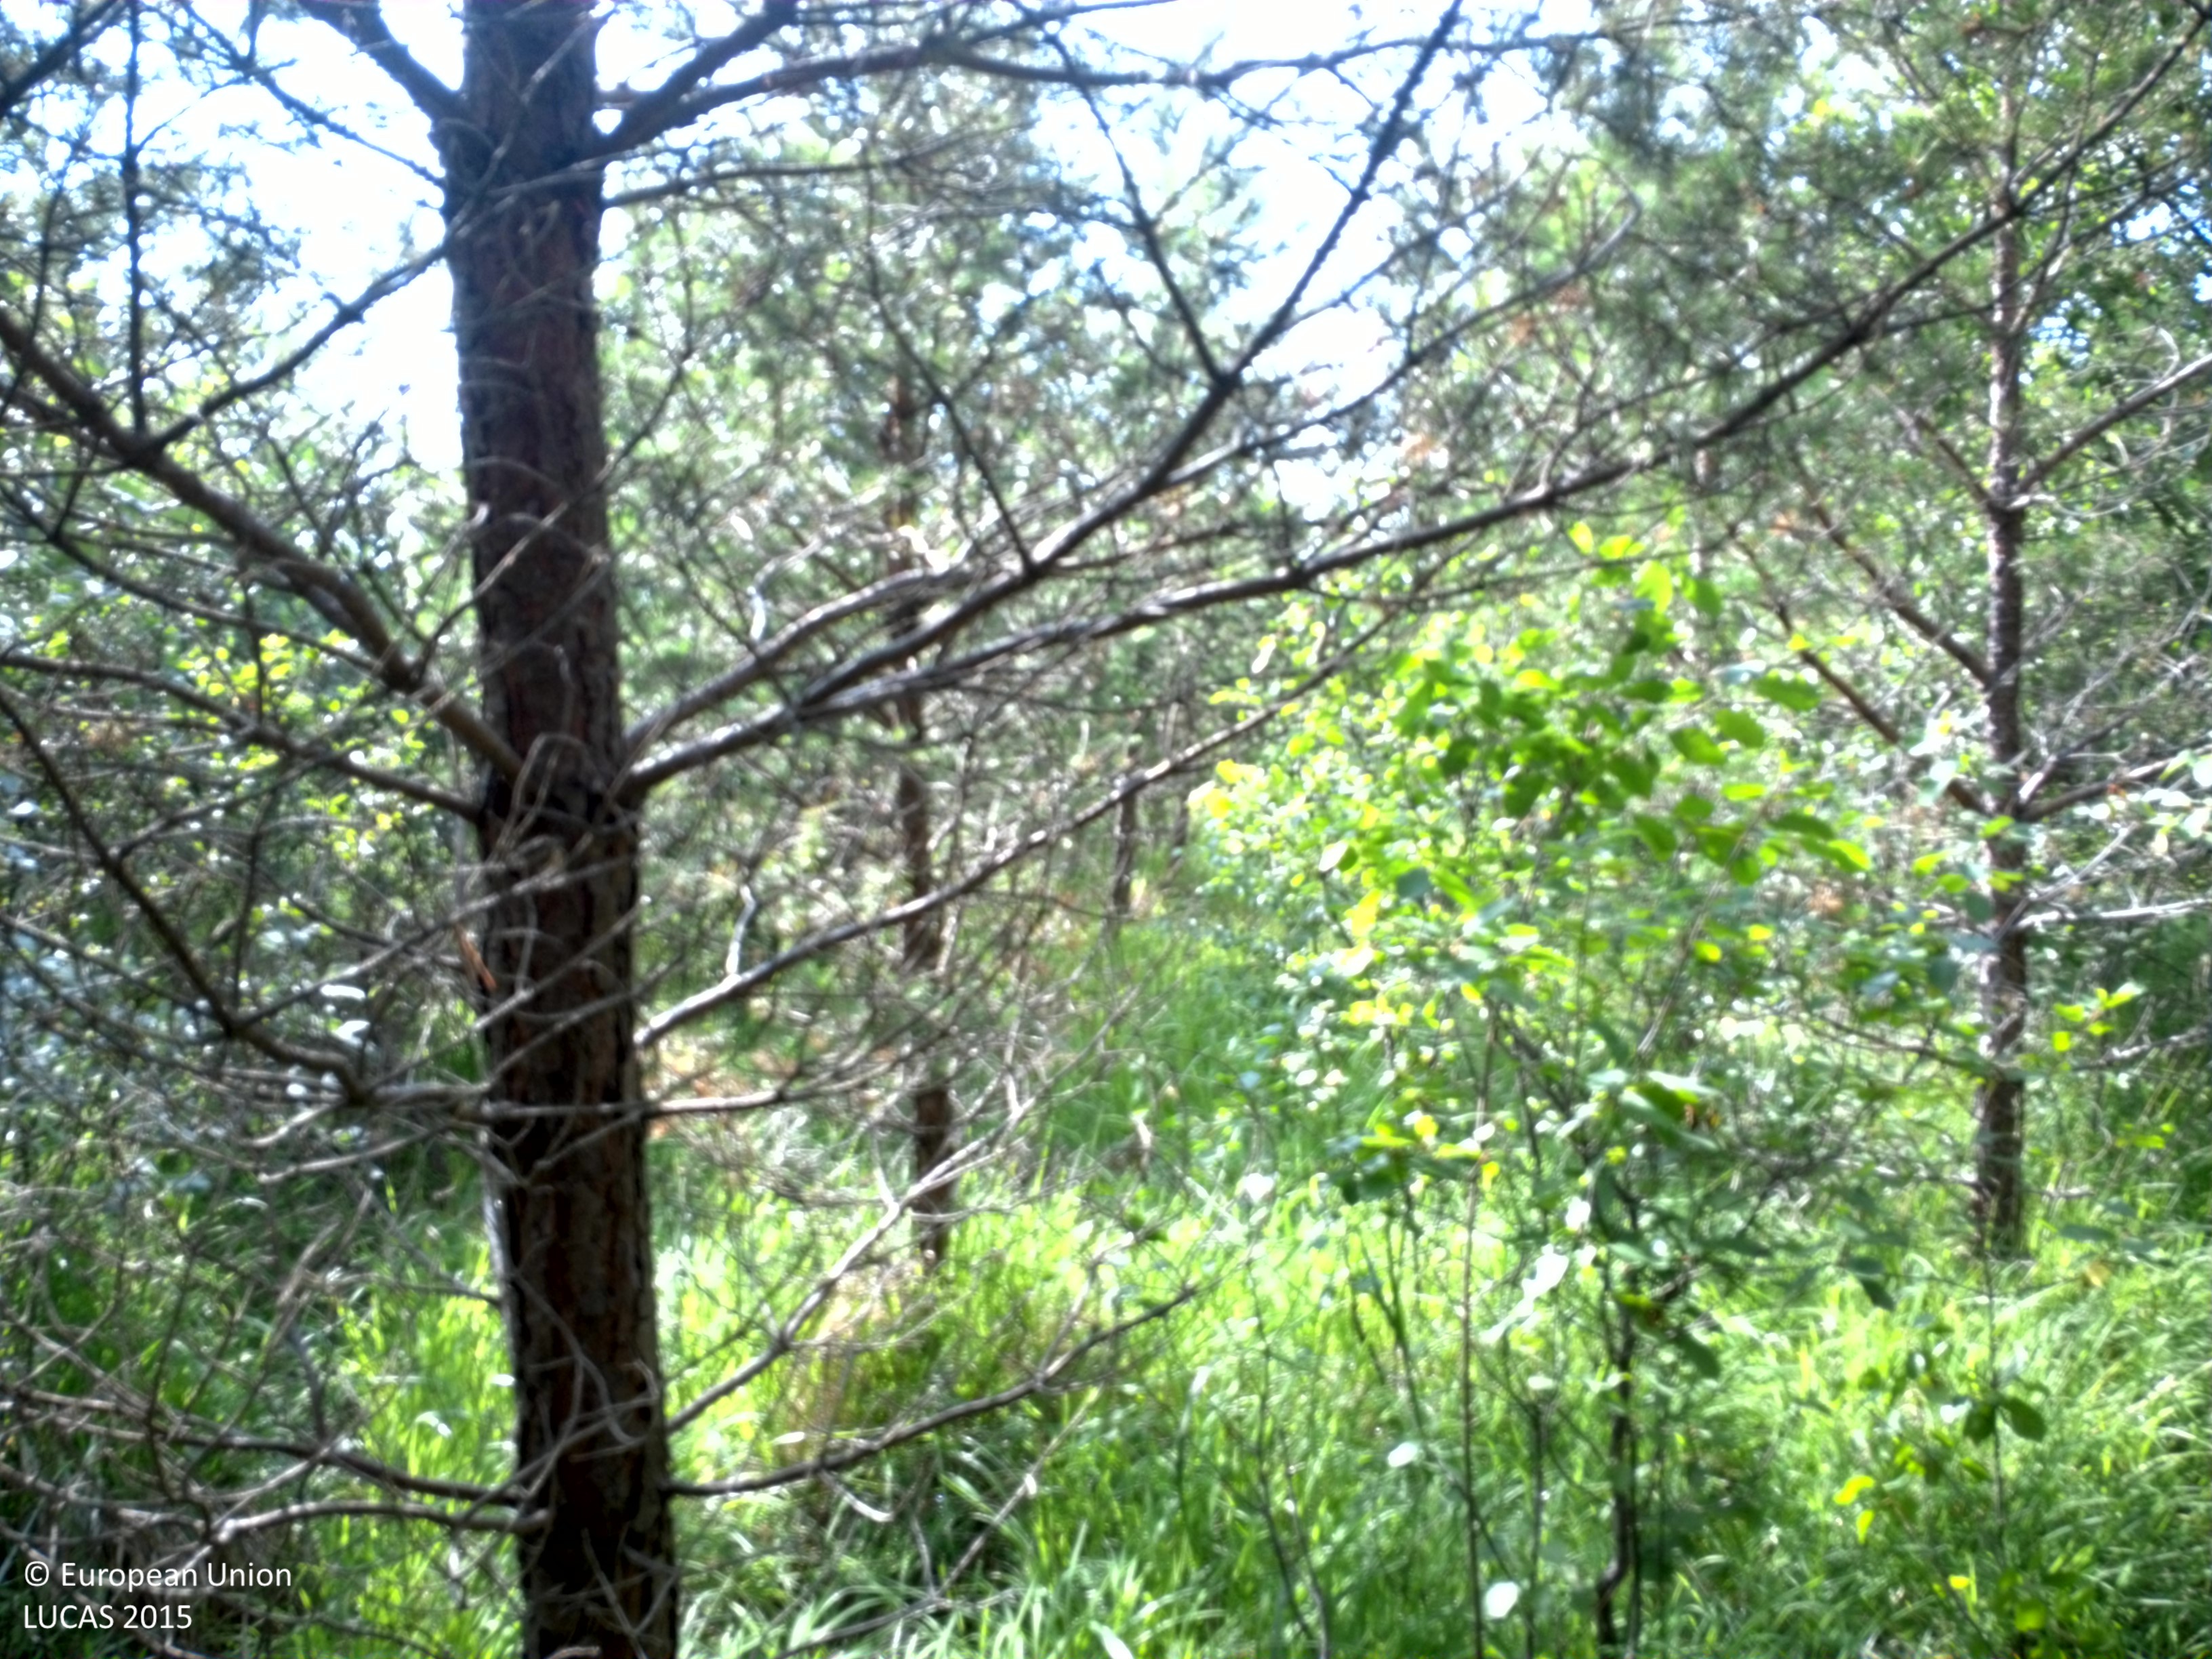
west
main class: Woodland
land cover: Pine dominated mixed woodland
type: hemiboreal forest and nemoral coniferous forest and mixed broadleaved-coniferous forest
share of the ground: > 75 %
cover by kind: coniferous forest trees 55 %, broadleaved forest trees 25 %, herbaceous plants 20 %
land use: Forestry
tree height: < 5 m
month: July
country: SE
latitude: 57.4288
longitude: 18.7209
